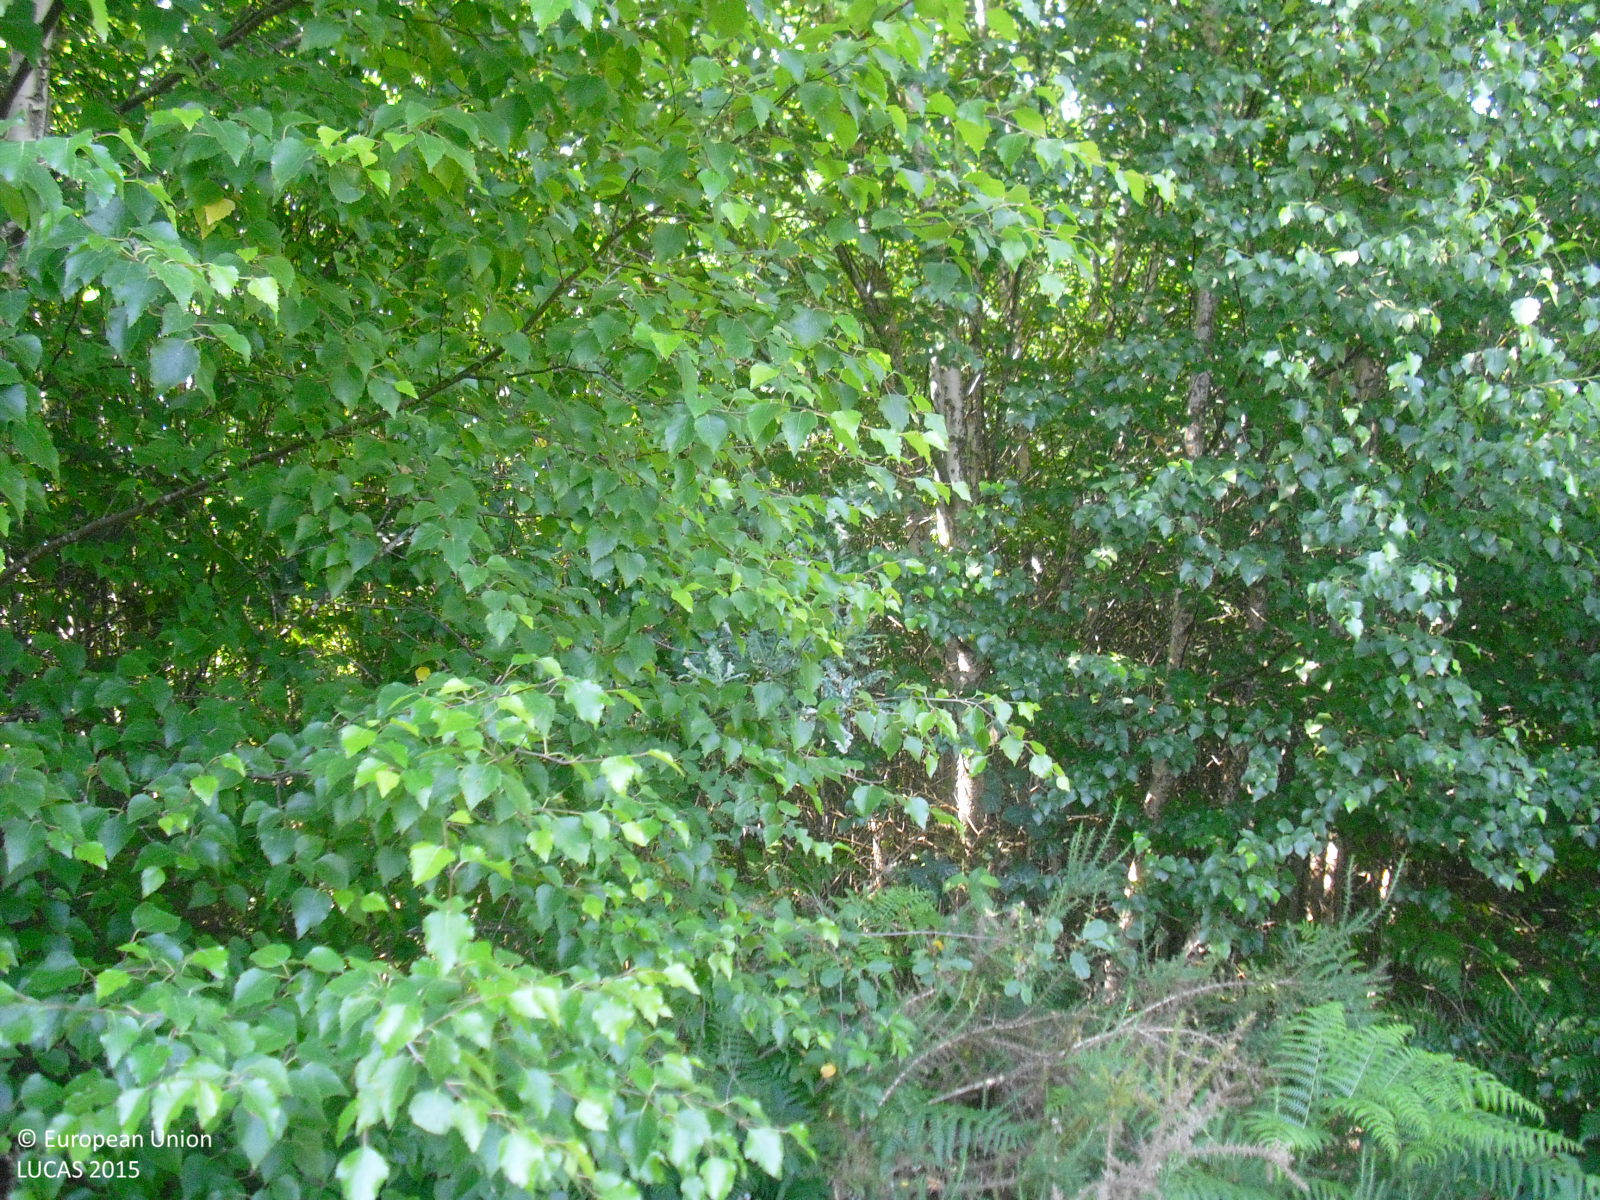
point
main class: Woodland
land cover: Broadleaved woodland
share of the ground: 50 - 75 %
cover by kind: broadleaved forest trees 60 %, shrubs 30 %, herbaceous plants 10 %
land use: Semi-natural and natural areas not in use
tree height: > 5 m
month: June
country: ES
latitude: 42.4304
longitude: -7.8861
